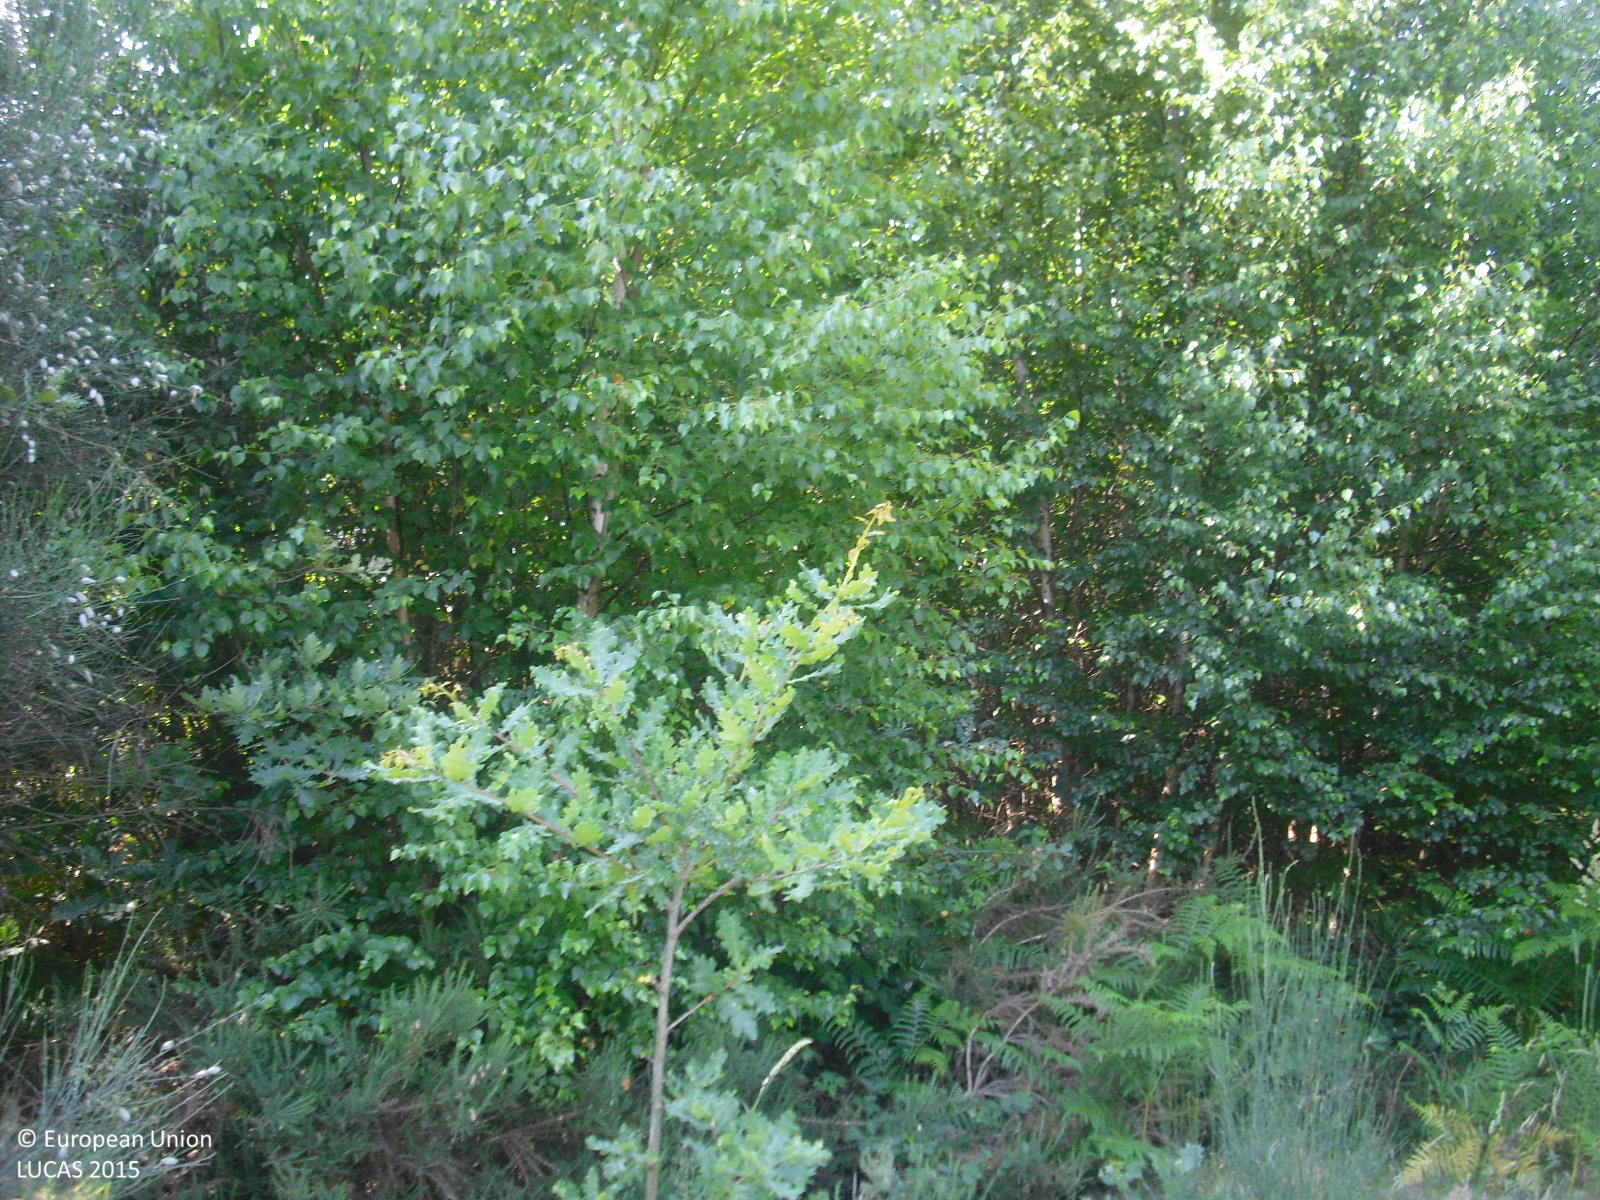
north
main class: Woodland
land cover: Broadleaved woodland
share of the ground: 50 - 75 %
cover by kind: broadleaved forest trees 60 %, shrubs 30 %, herbaceous plants 10 %
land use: Semi-natural and natural areas not in use
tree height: > 5 m
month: June
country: ES
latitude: 42.4304
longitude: -7.8861
